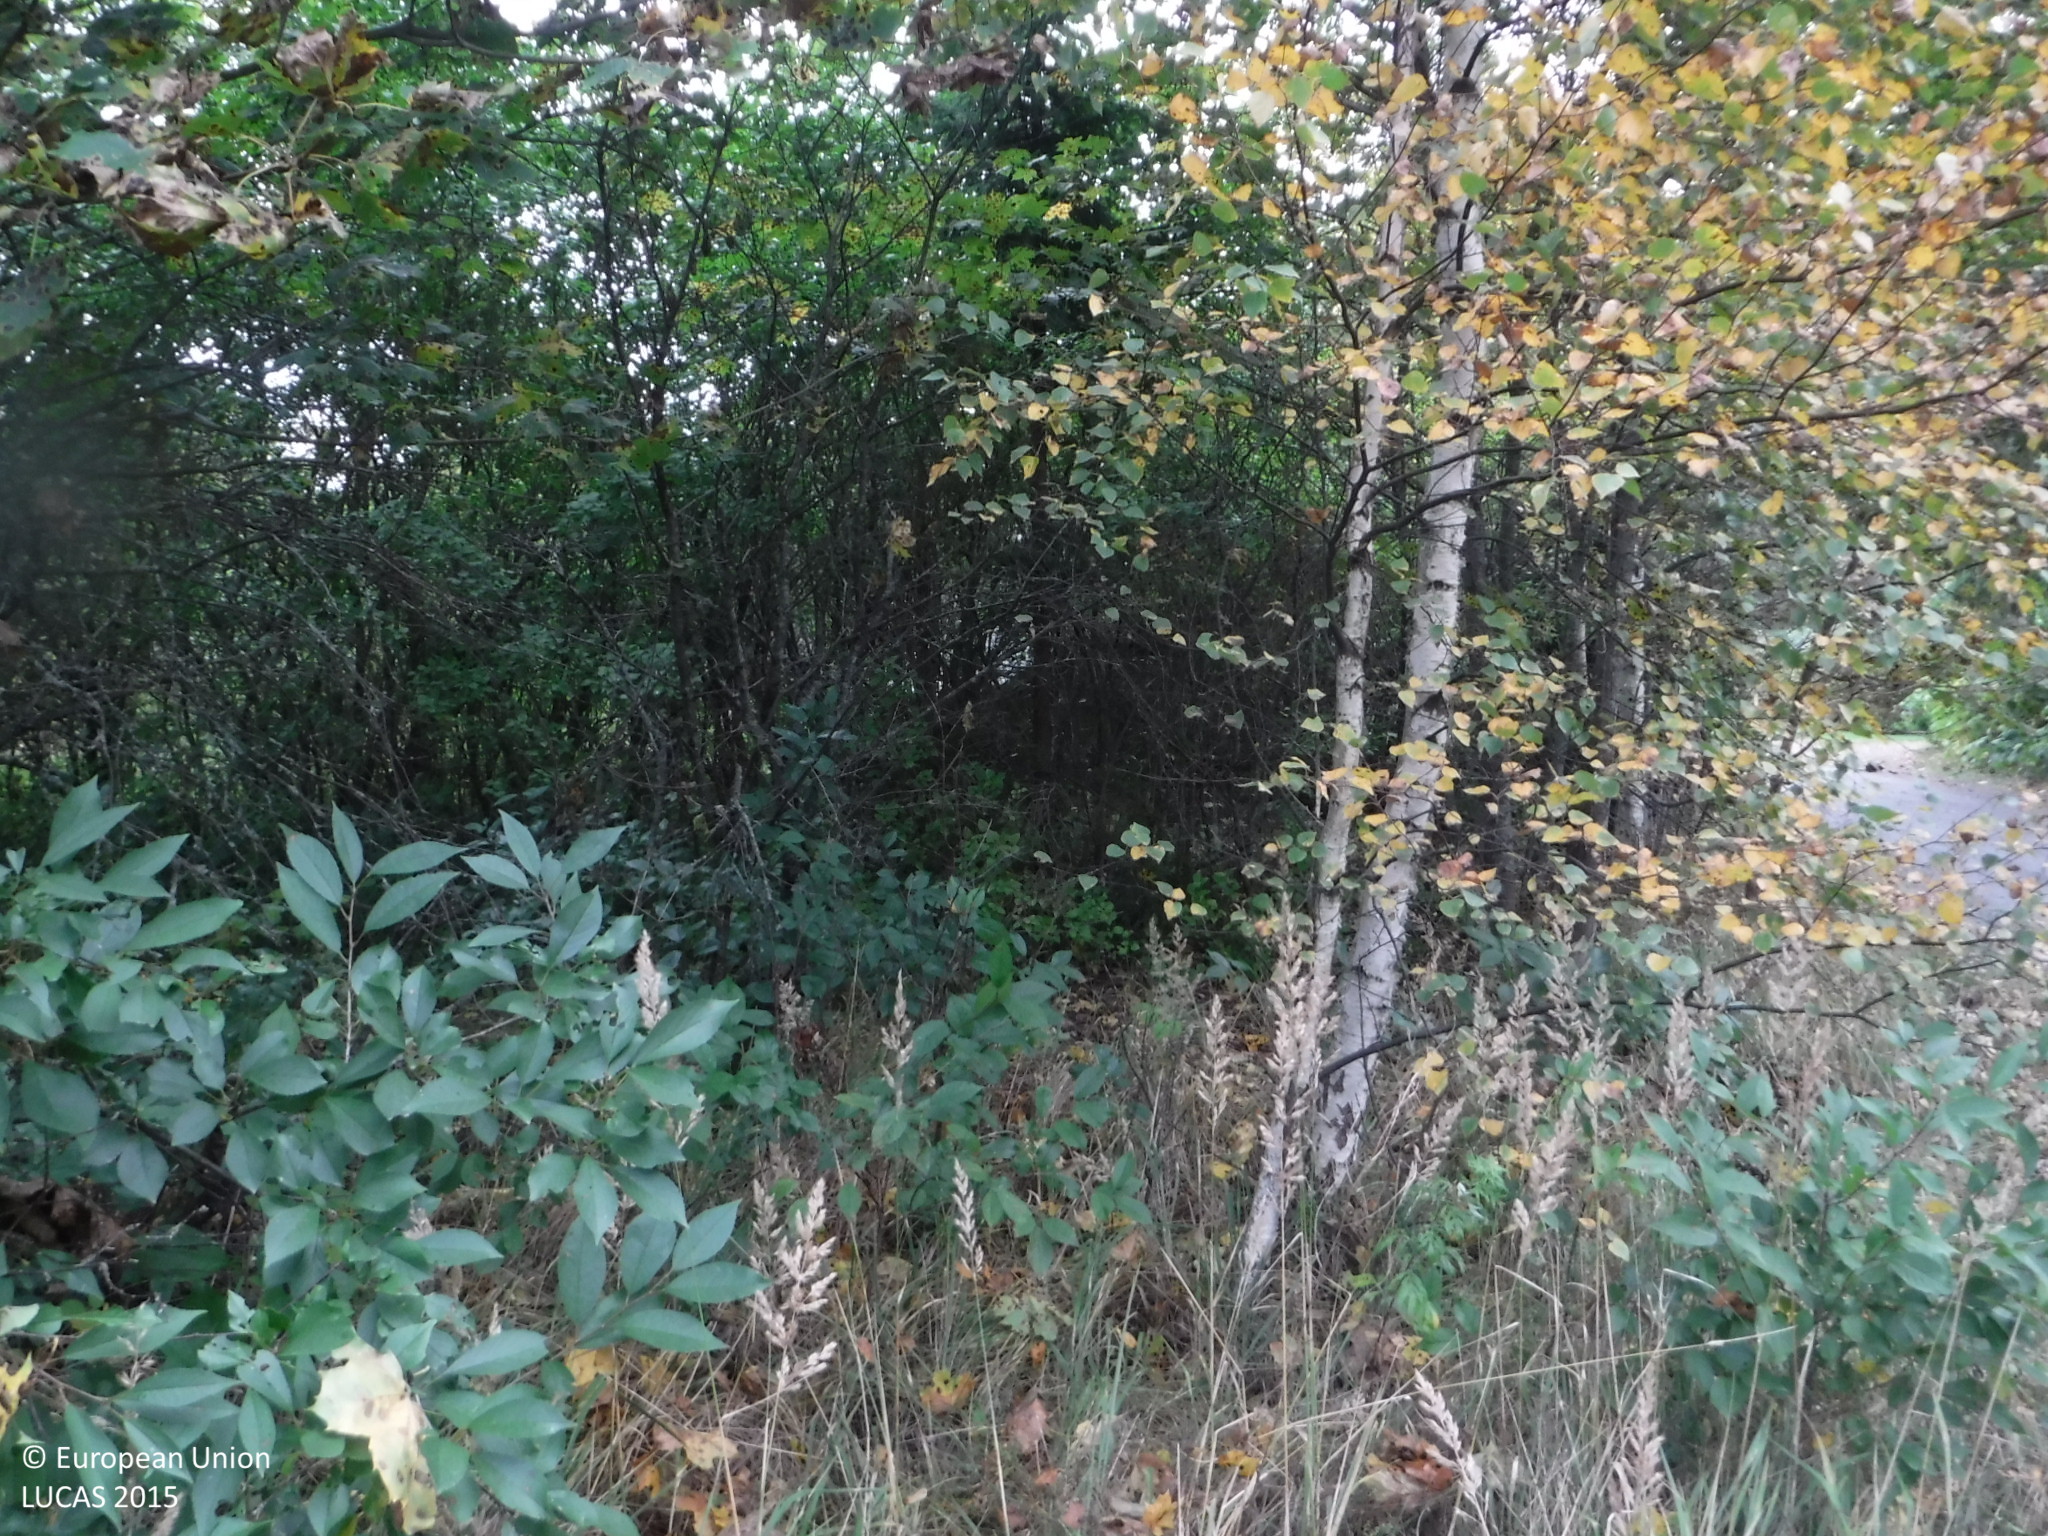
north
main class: Woodland
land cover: Broadleaved woodland
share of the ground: > 75 %
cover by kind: broadleaved forest trees 80 %, herbaceous plants 20 %
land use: Semi-natural and natural areas not in use
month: September
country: FI
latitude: 61.4871
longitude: 24.0805
